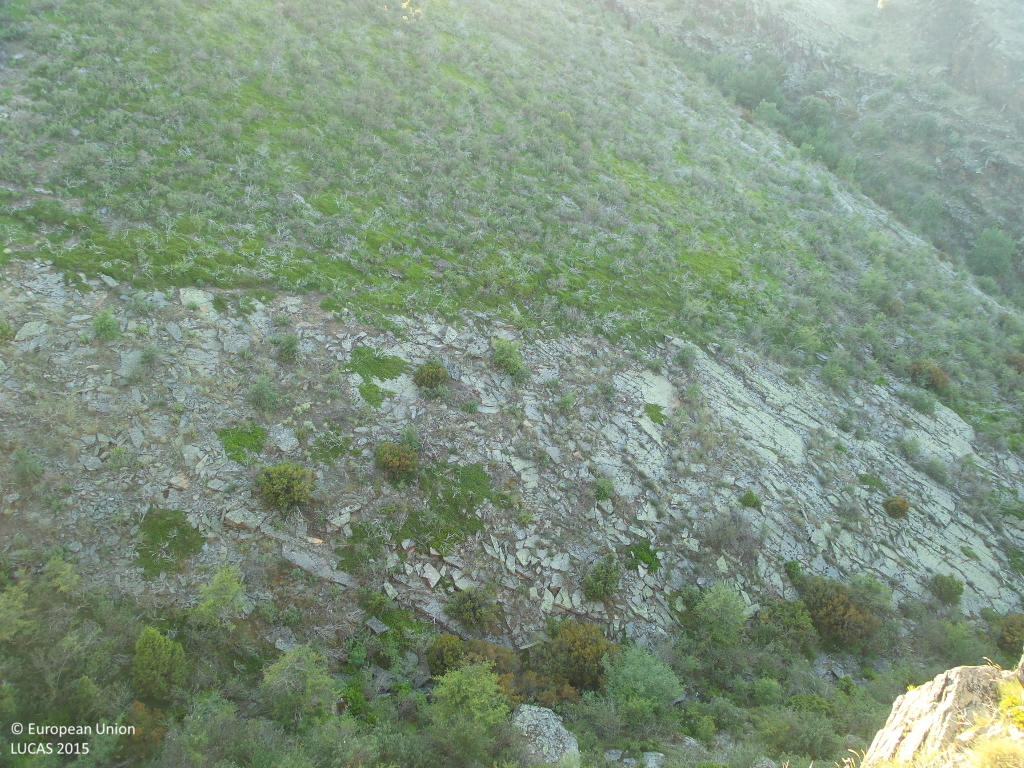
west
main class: Shrubland
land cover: Shrubland without tree cover
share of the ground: 25 - 50 %
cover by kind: shrubs 40 %, consolidated bare surface 40 %, unconsolidated bare surface 20 %
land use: Semi-natural and natural areas not in use
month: June
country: ES
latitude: 41.2058
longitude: -3.0255
